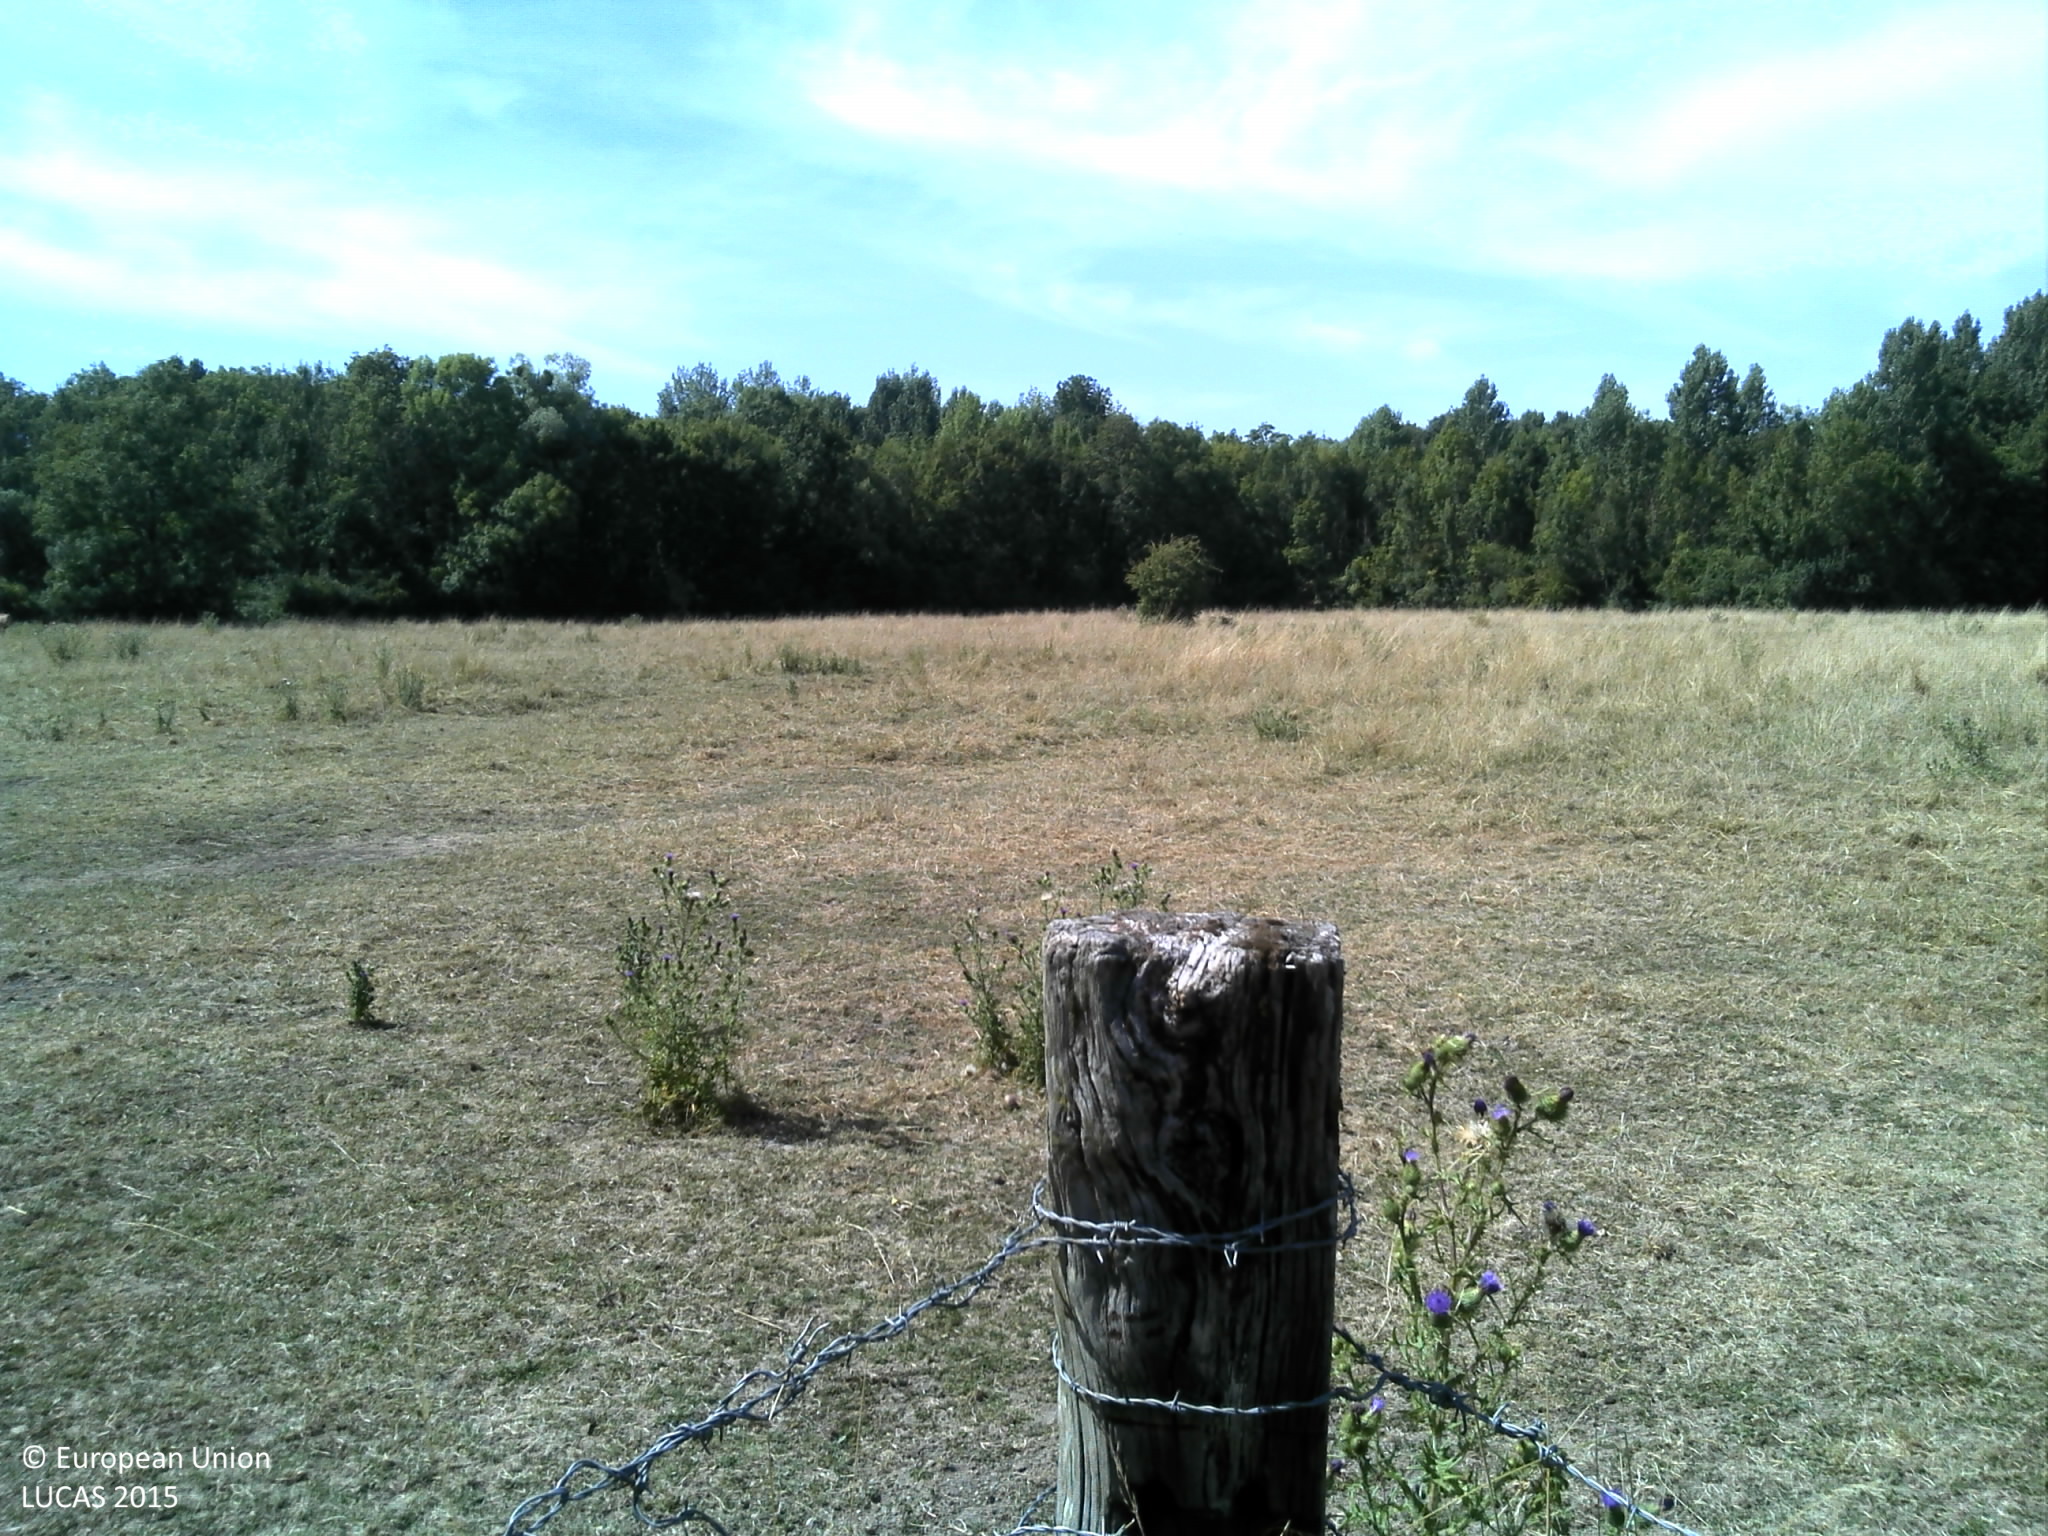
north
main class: Grassland
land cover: Grassland without tree/shrub cover
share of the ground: > 75 %
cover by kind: herbaceous plants 90 %, shrubs 5 %, consolidated bare surface 5 %
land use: Agriculture (excluding fallow land and kitchen gardens)
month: August
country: FR
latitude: 49.1812
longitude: 4.7703
